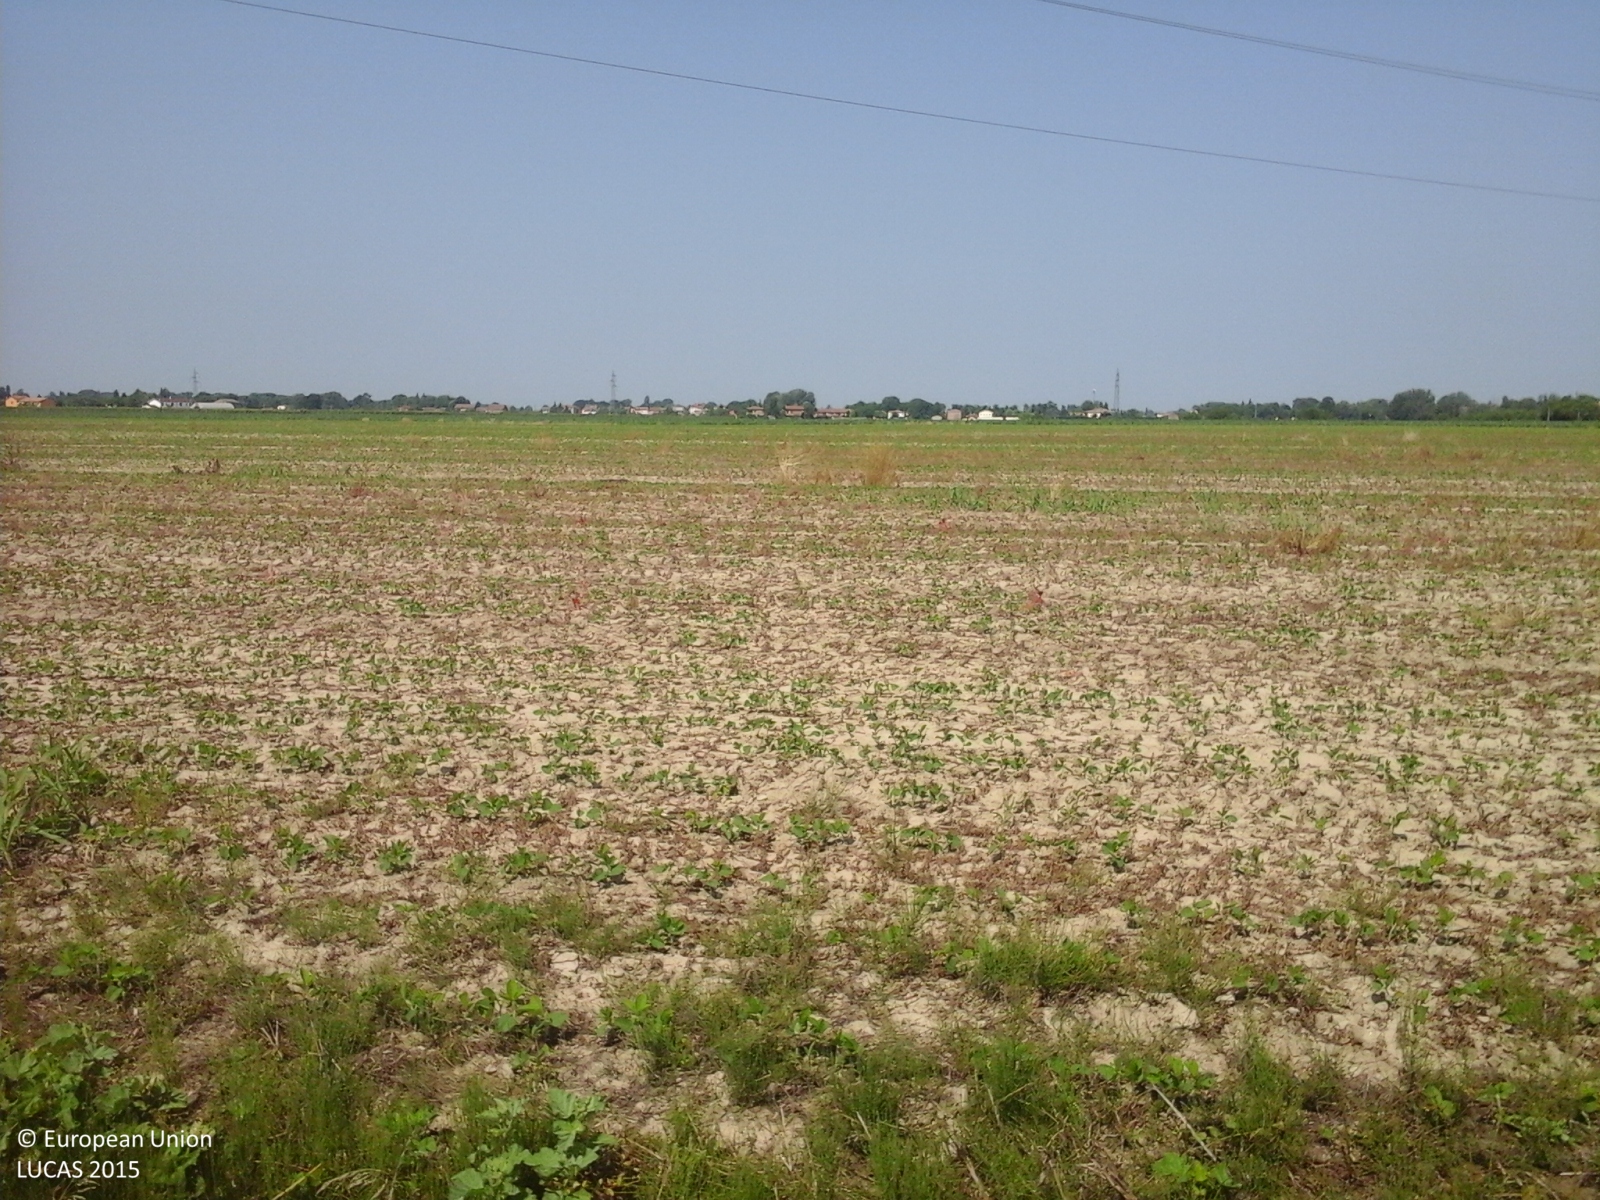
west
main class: Artificial land
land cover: Non built-up linear features
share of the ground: > 75 %
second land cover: Grassland without tree/shrub cover
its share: > 75 %
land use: Road transport
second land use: Agriculture (excluding fallow land and kitchen gardens)
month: May
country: IT
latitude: 44.8060
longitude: 11.6782
